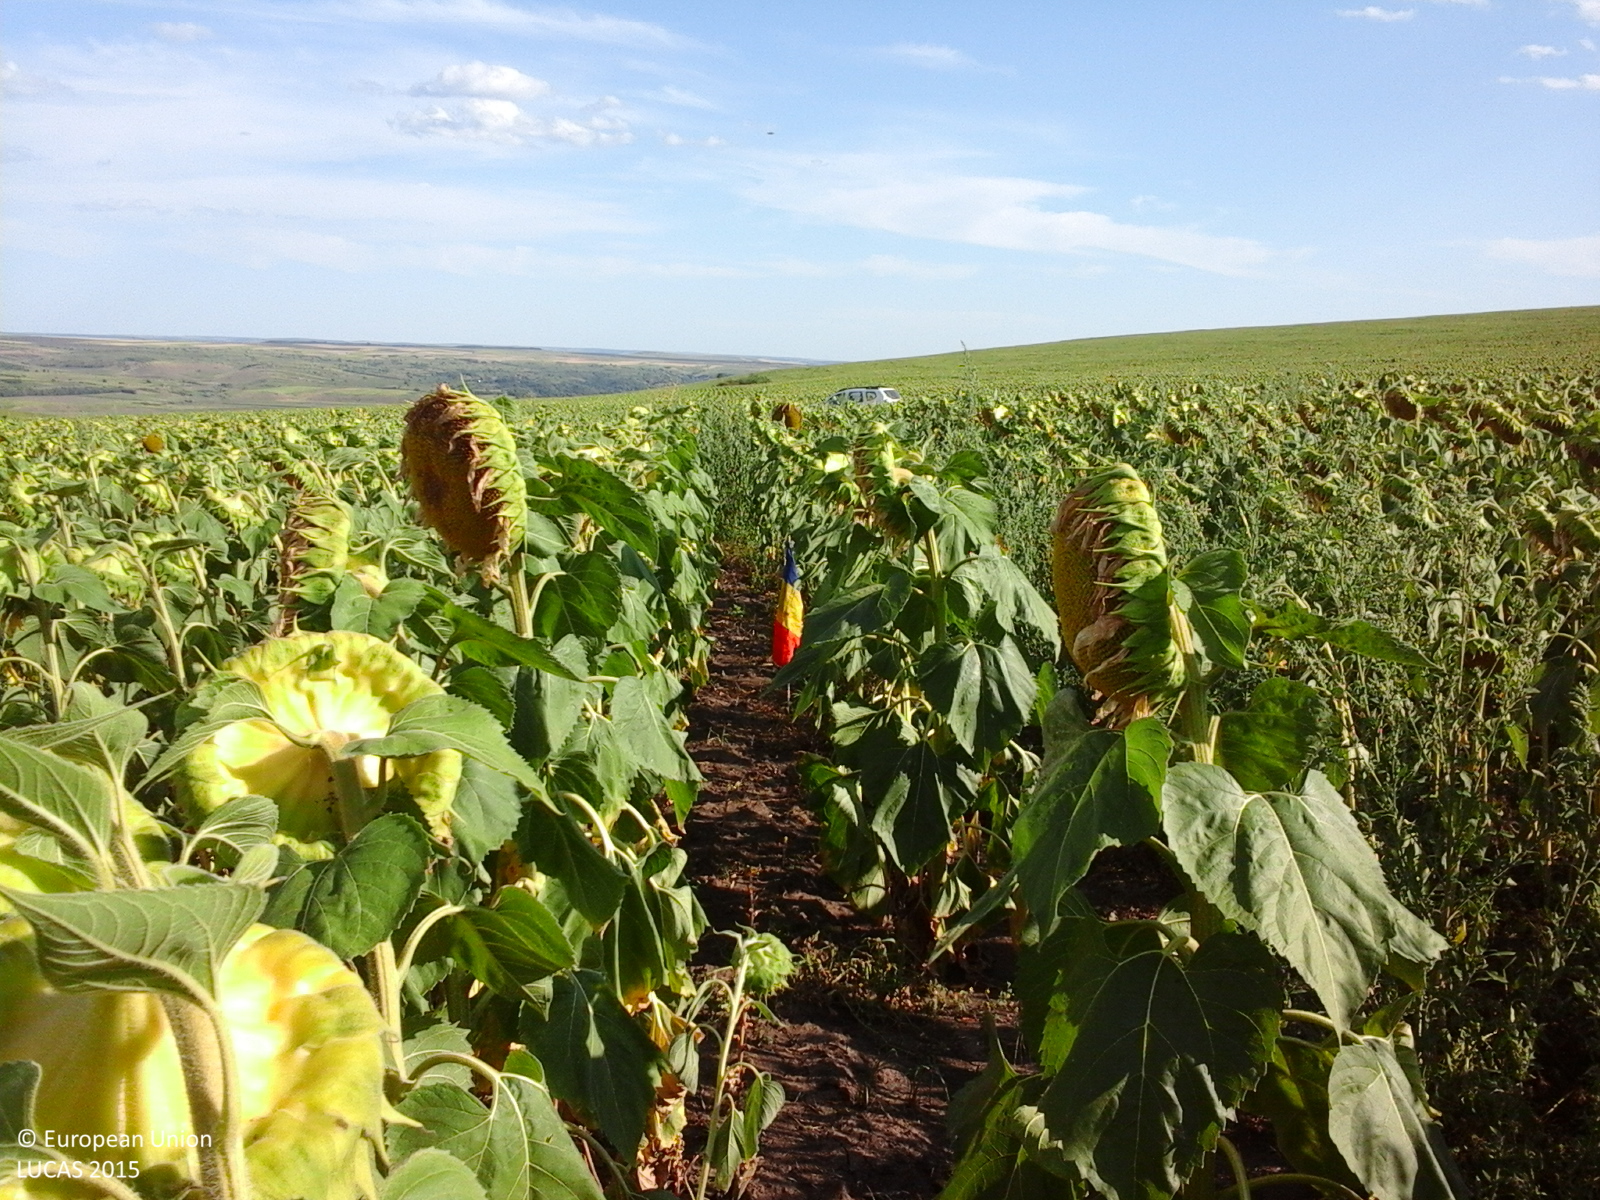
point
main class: Cropland
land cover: Sunflower
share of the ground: > 75 %
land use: Agriculture (excluding fallow land and kitchen gardens)
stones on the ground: < 10 %
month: July
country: RO
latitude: 46.2341
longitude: 27.5243
